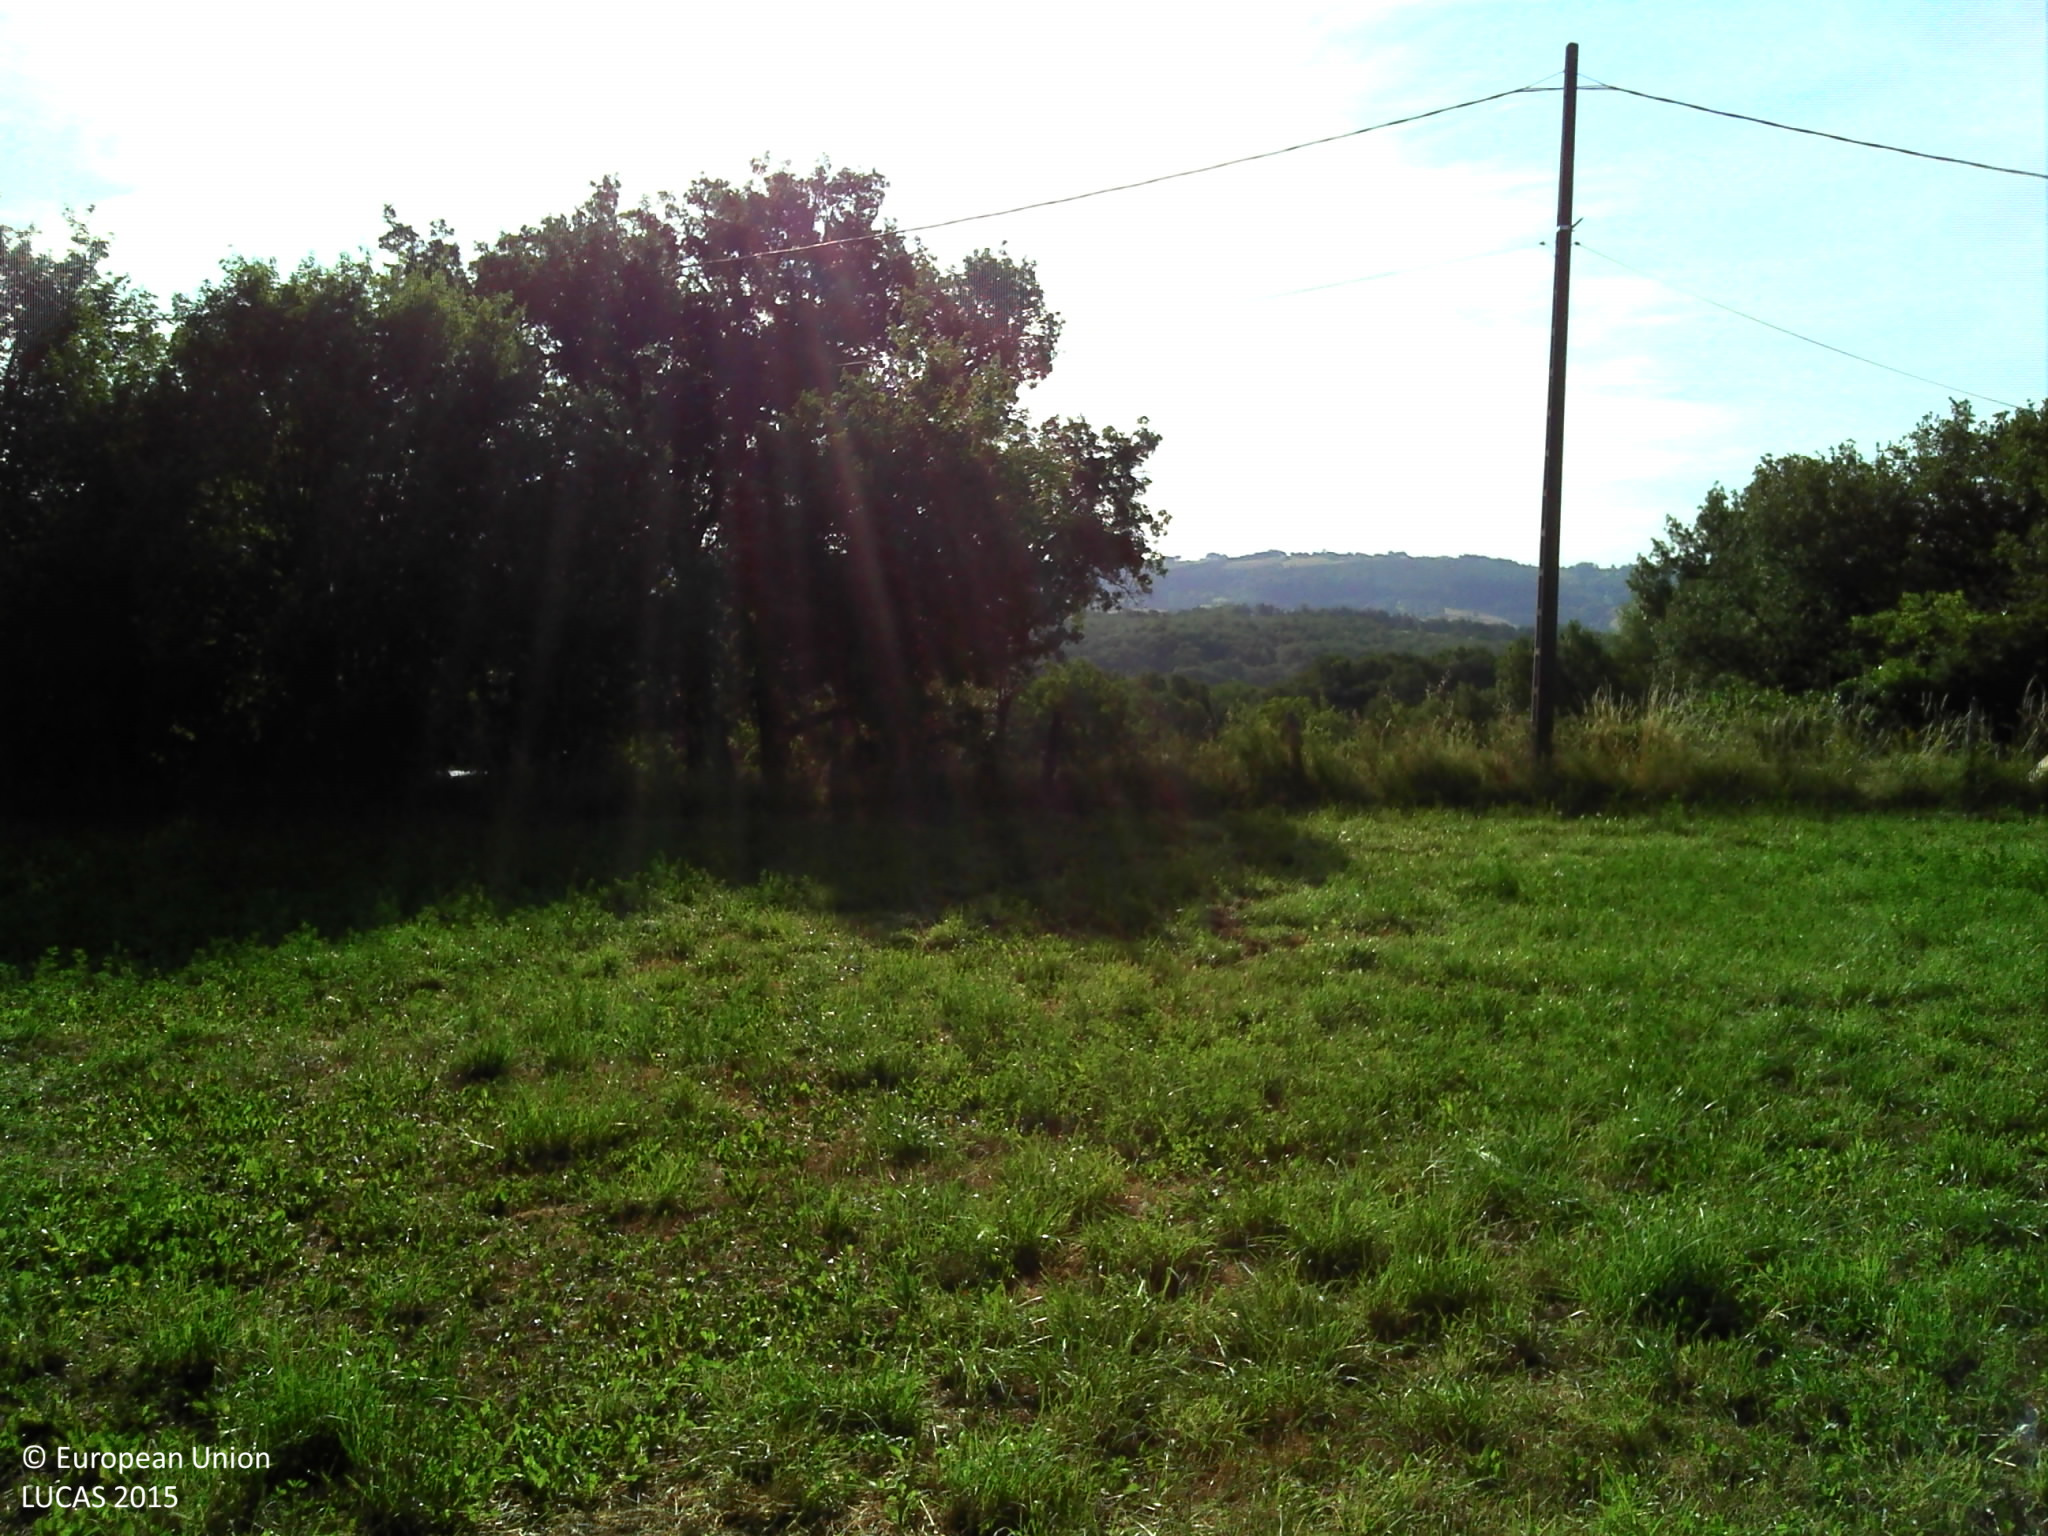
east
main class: Cropland
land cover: Lucerne
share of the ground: 50 - 75 %
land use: Agriculture (excluding fallow land and kitchen gardens)
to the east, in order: Lucerne; Managed hedges; Electric lines; Grass margins; Paved roads, cycling and walking lanes; Grass margins; Dry stone walls; Artificial constructions in urban areas; Dry stone walls; Grassland without tree/shrub cover; Fences; Broadleaved woodland; Fences; Grassland without tree/shrub cover; Electric lines; Grassland without tree/shrub cover; Broadleaved woodland; Fences; Dry stone walls; Broadleaved woodland
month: June
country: FR
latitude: 44.4058
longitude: 2.0276
